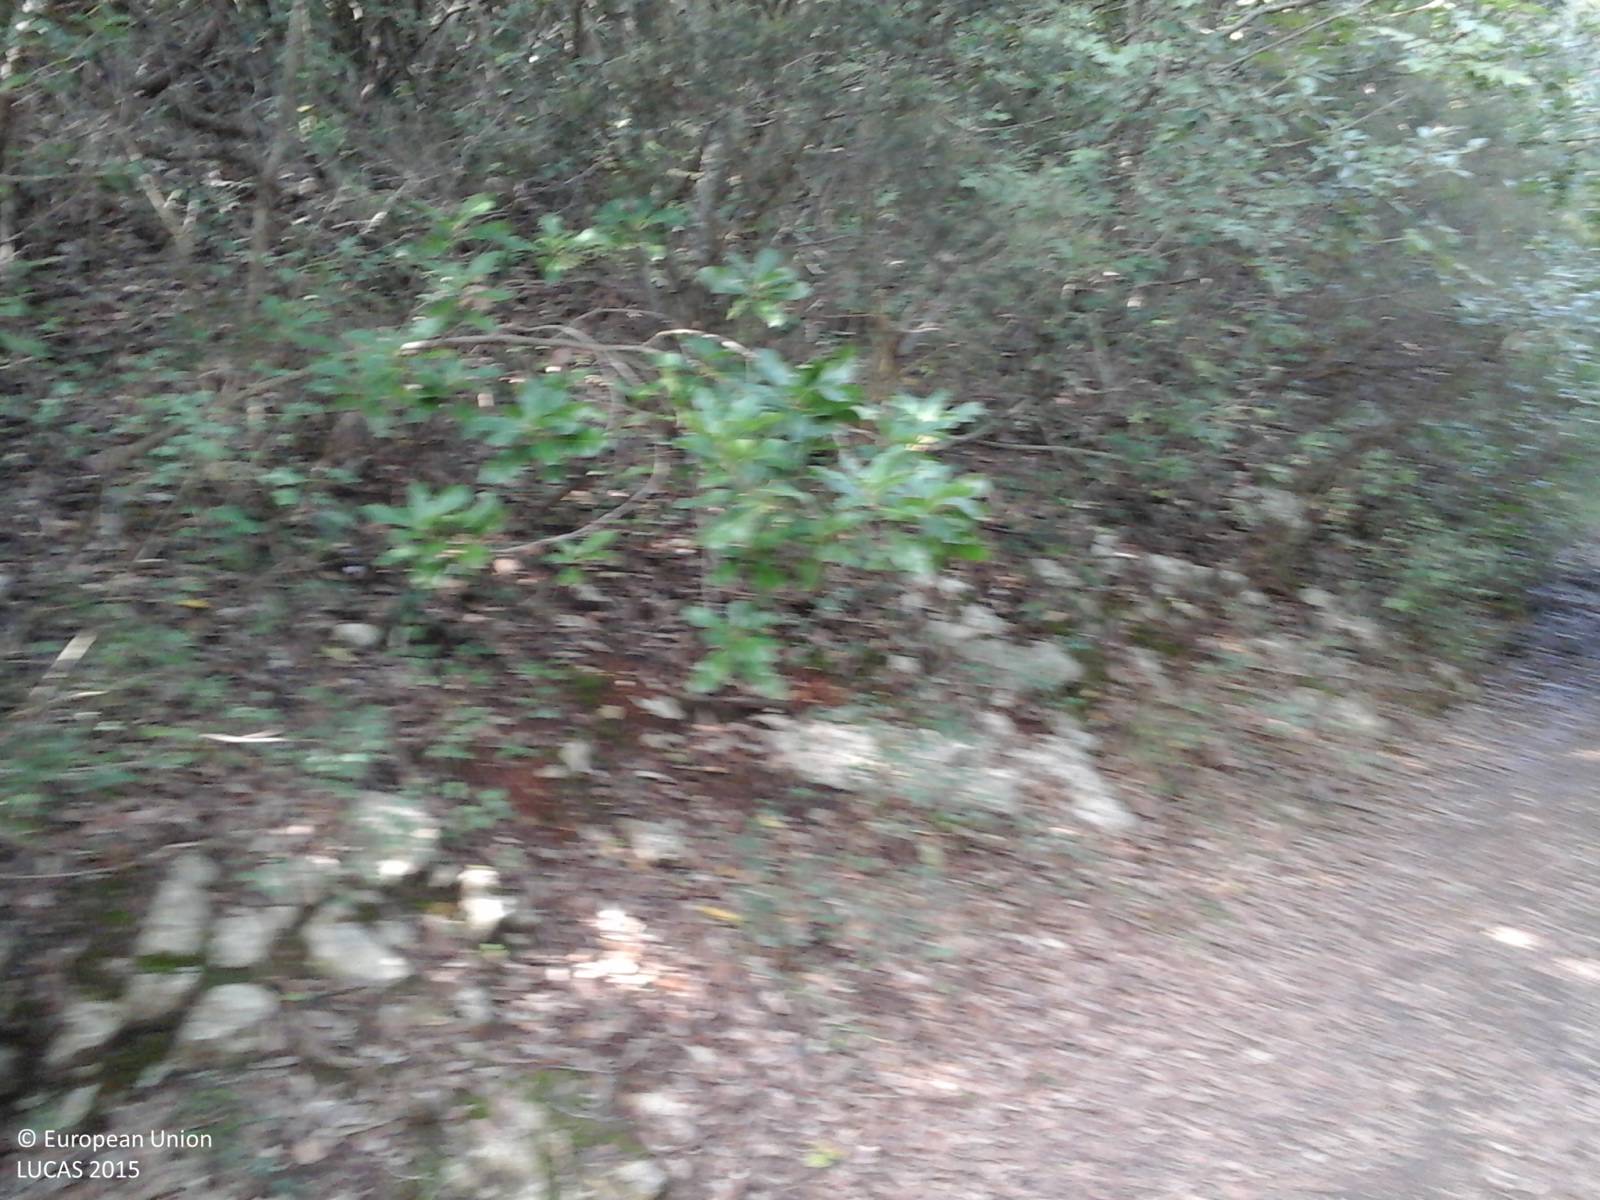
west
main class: Woodland
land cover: Broadleaved woodland
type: broadleaved evergreen forest
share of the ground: > 75 %
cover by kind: broadleaved forest trees 95 %, shrubs 5 %
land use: Forestry
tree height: > 5 m
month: October
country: IT
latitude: 42.6460
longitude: 12.2978
